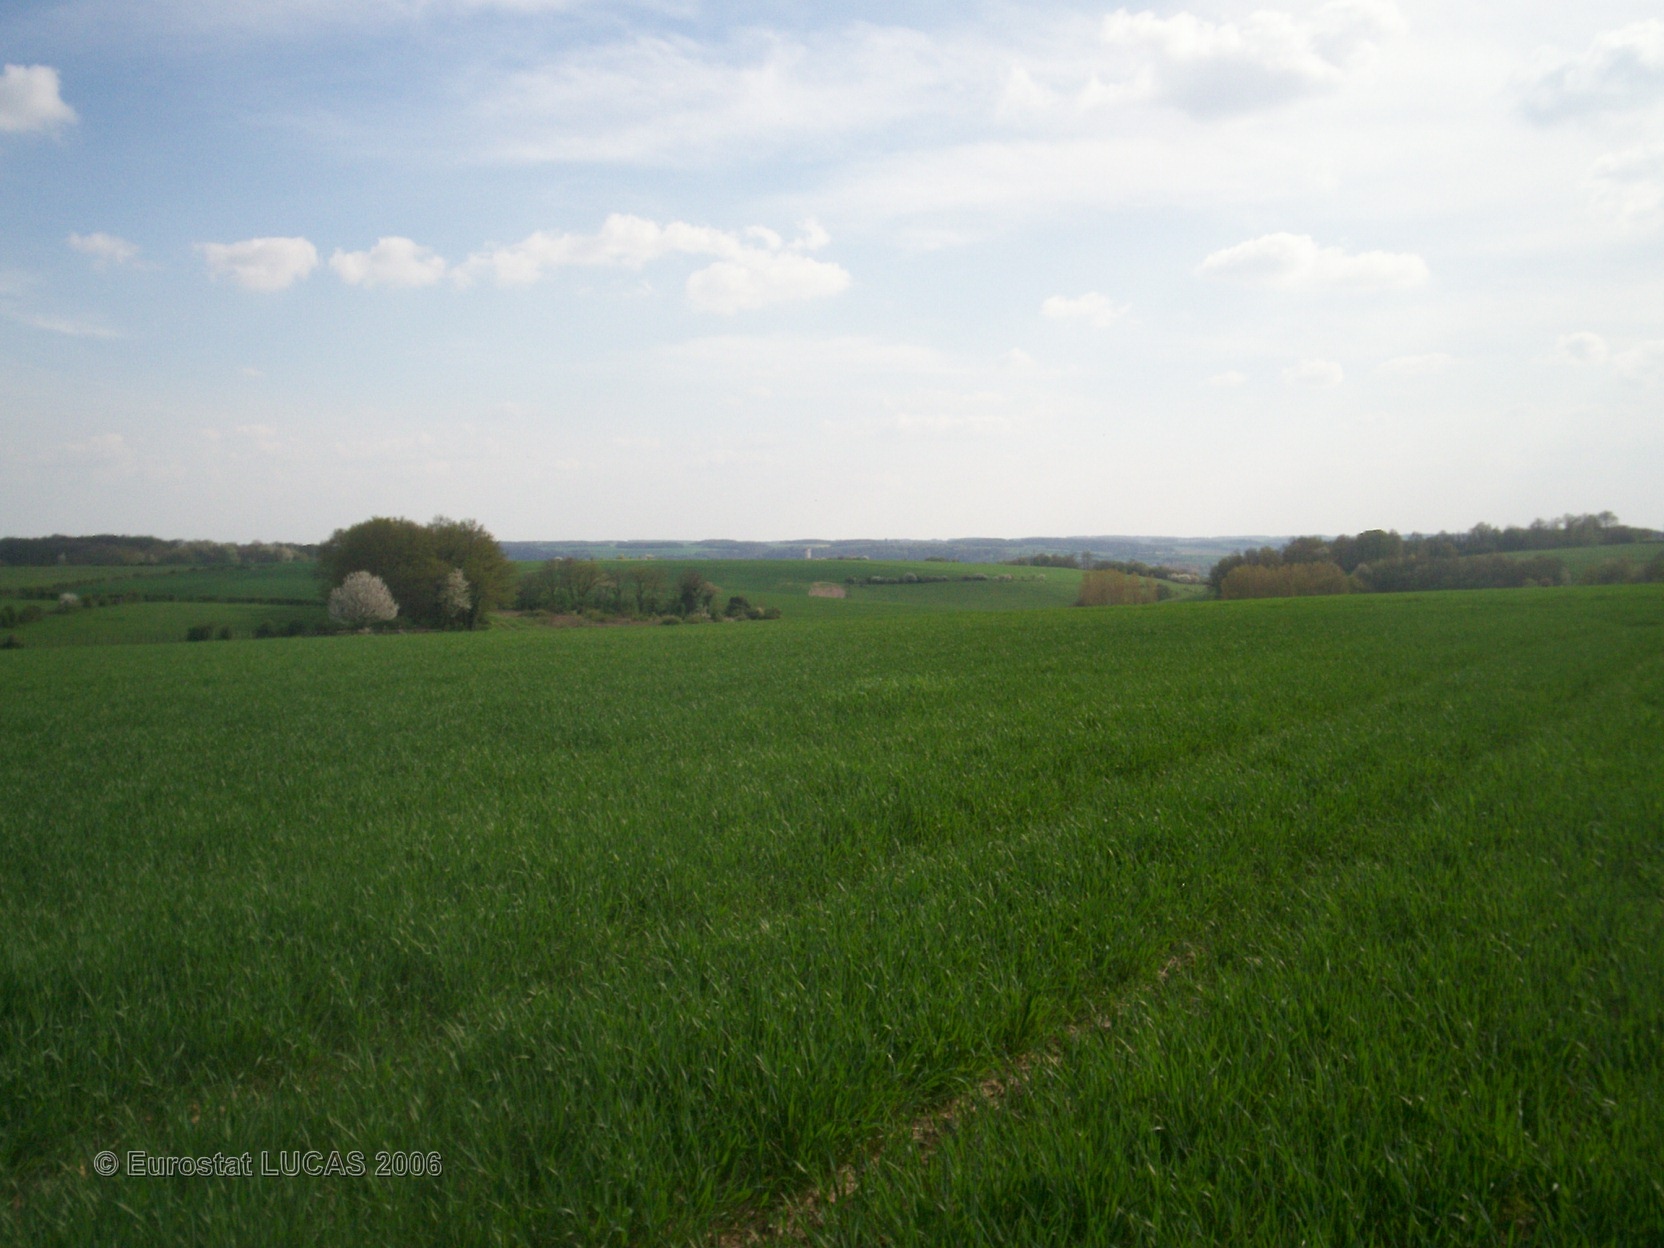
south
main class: Cropland
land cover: Common wheat
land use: Agriculture (excluding fallow land and kitchen gardens)
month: April
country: FR
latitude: 47.7891
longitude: 0.8635
